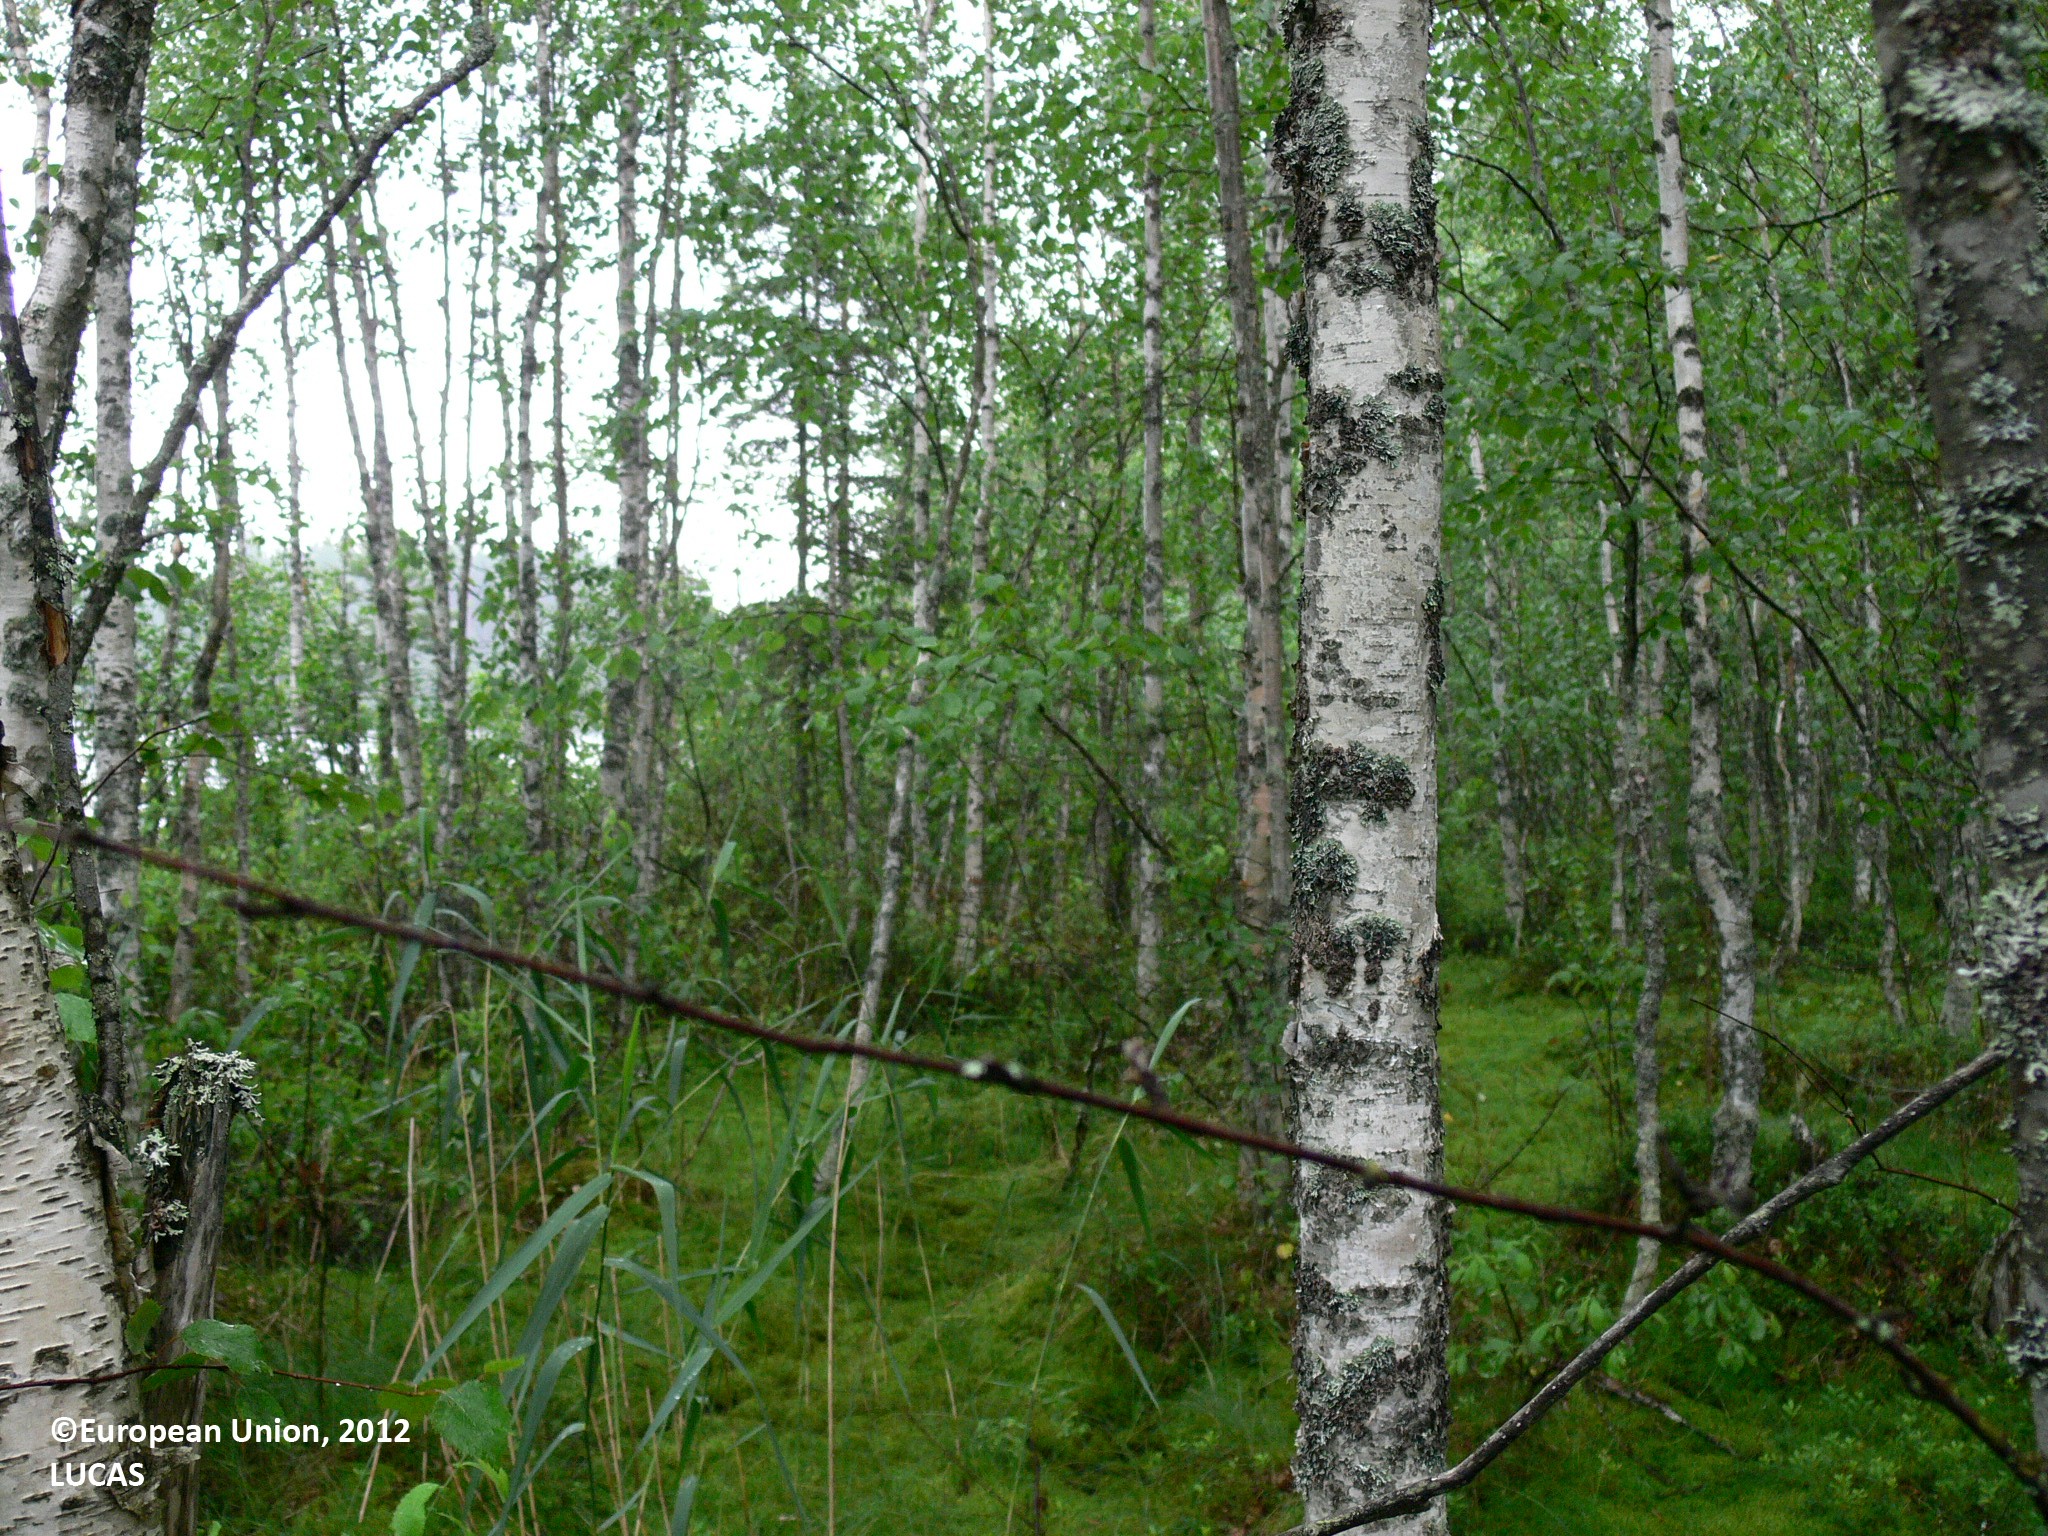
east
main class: Woodland
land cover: Pine dominated mixed woodland
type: boreal forest
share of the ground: > 75 %
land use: Semi-natural and natural areas not in use
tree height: > 5 m
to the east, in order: Pine dominated mixed woodland; Inland water bodies; Pine dominated mixed woodland
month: July
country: FI
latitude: 63.1052
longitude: 30.7971
